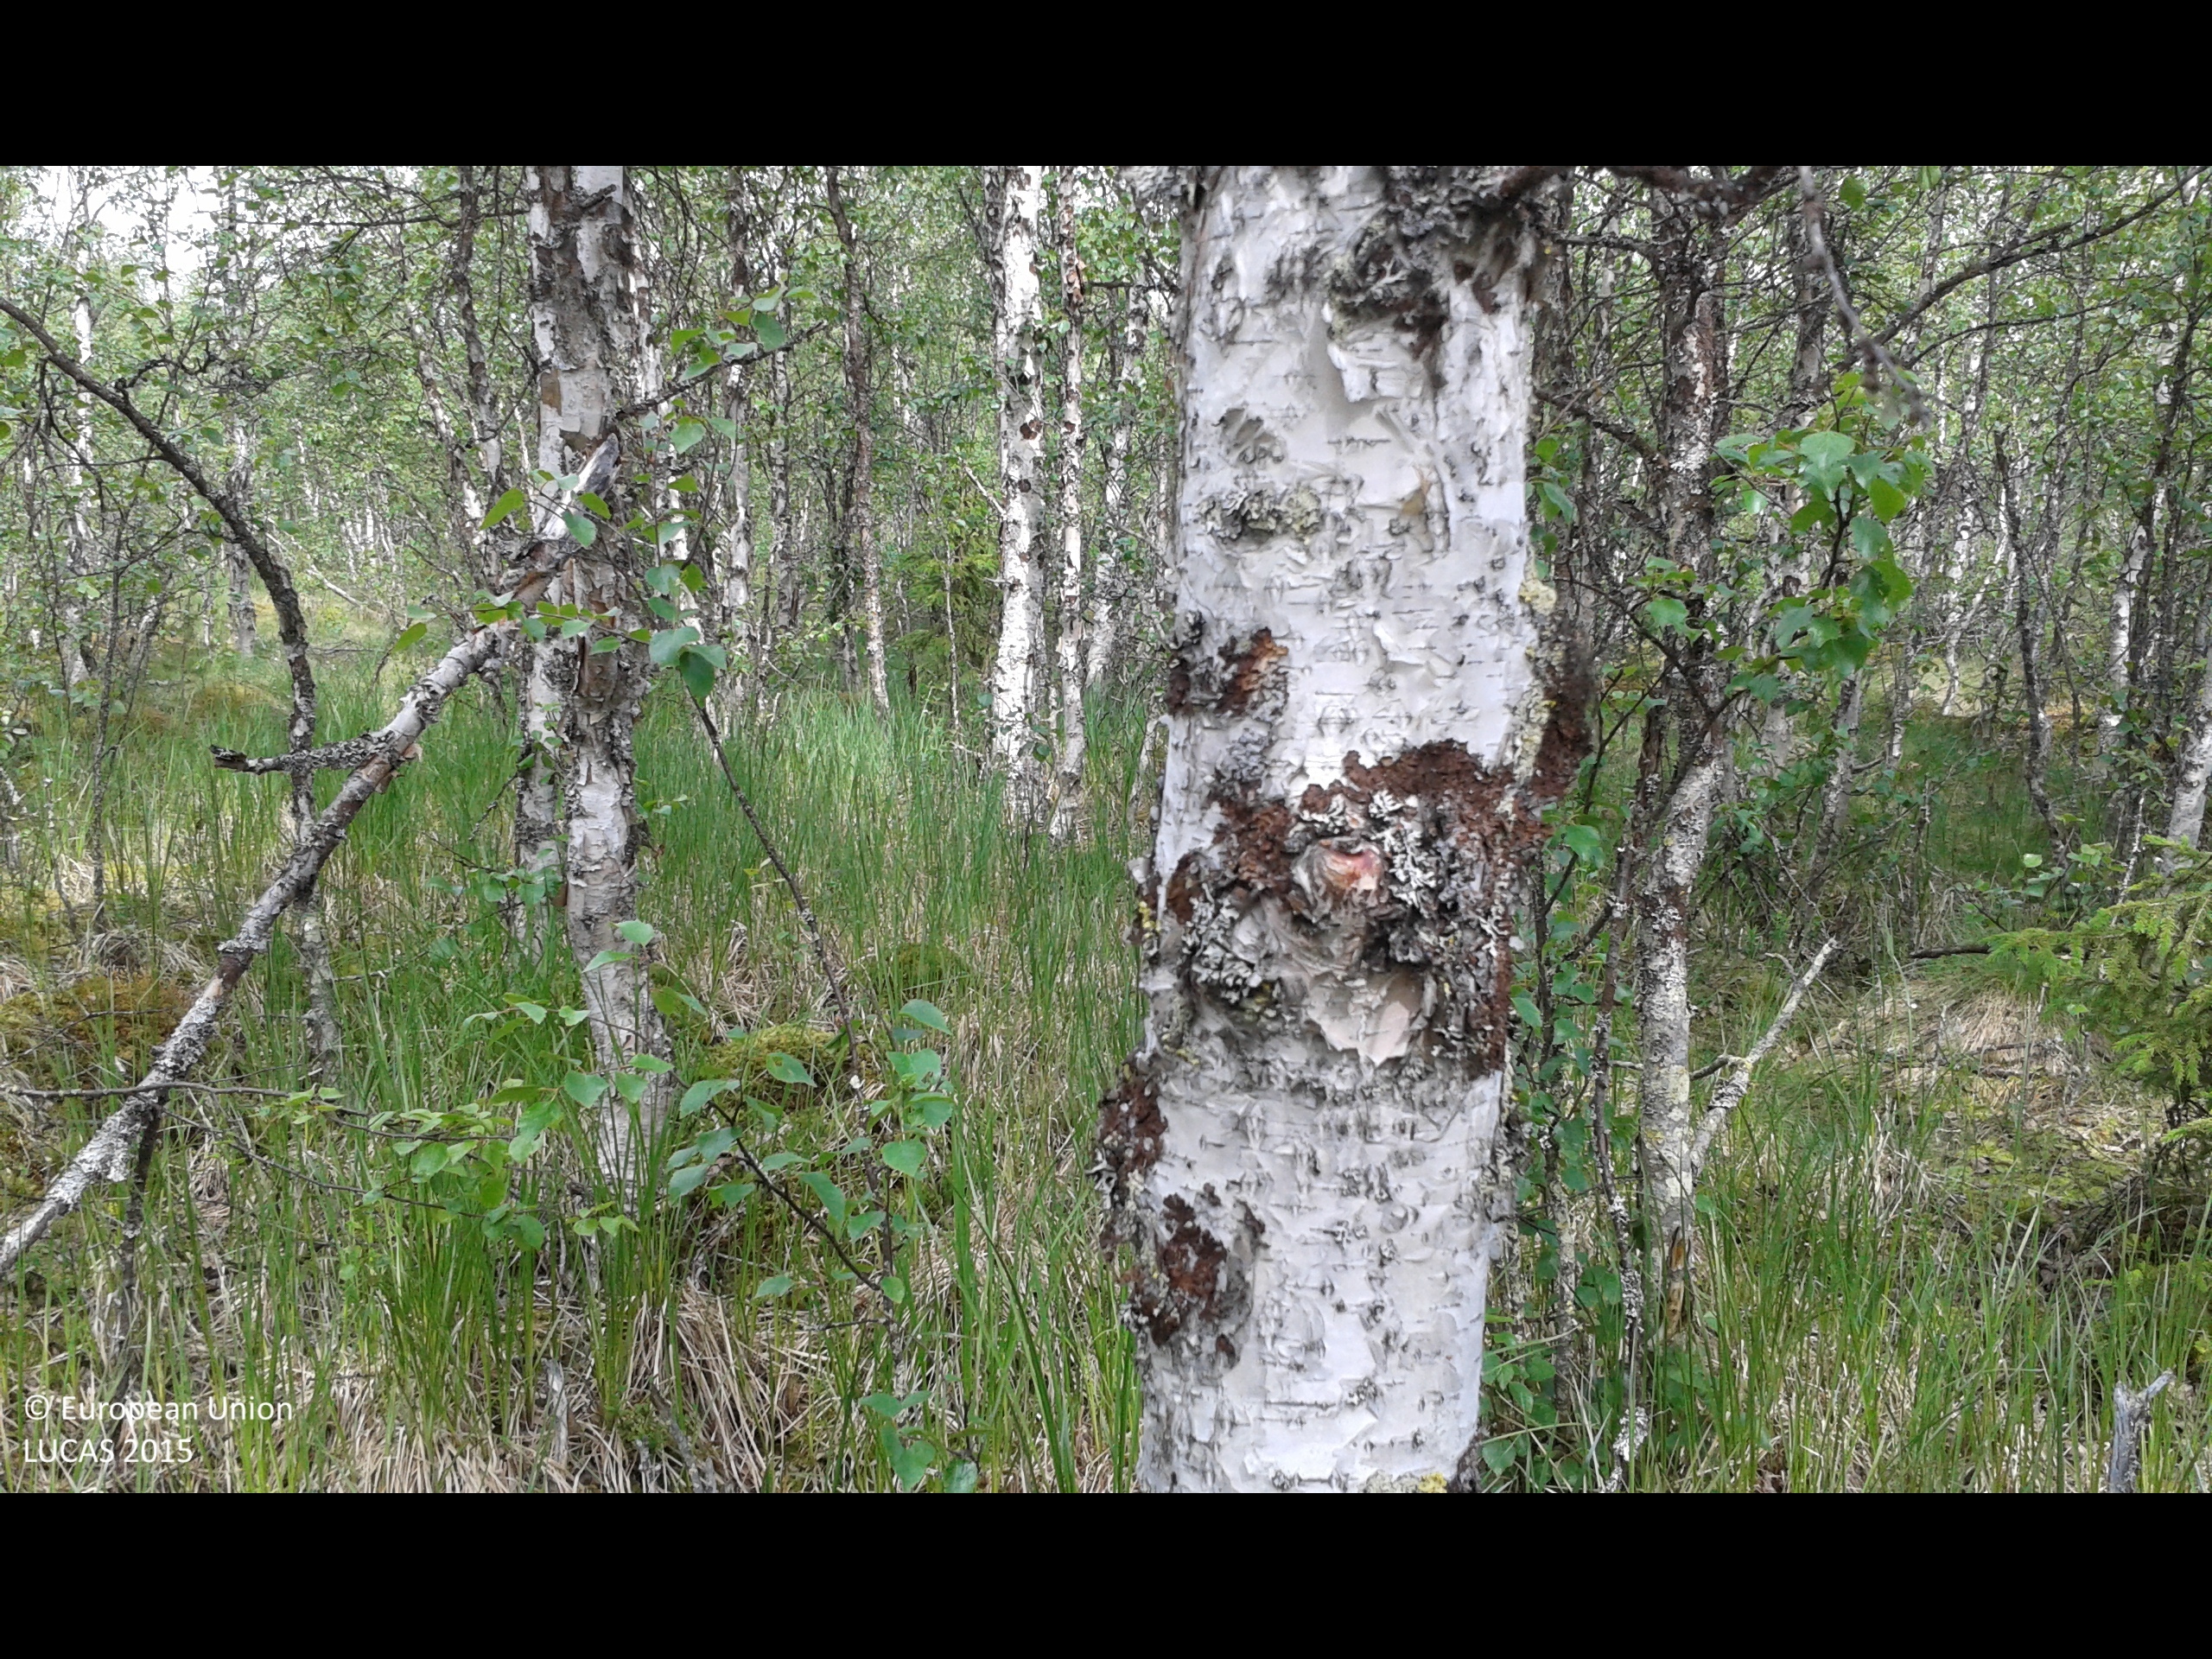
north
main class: Woodland
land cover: Broadleaved woodland
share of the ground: 25 - 50 %
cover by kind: herbaceous plants 40 %, broadleaved forest trees 30 %, lichens and mosses 30 %
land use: Forestry
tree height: > 5 m
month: July
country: SE
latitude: 67.0137
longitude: 23.1206
